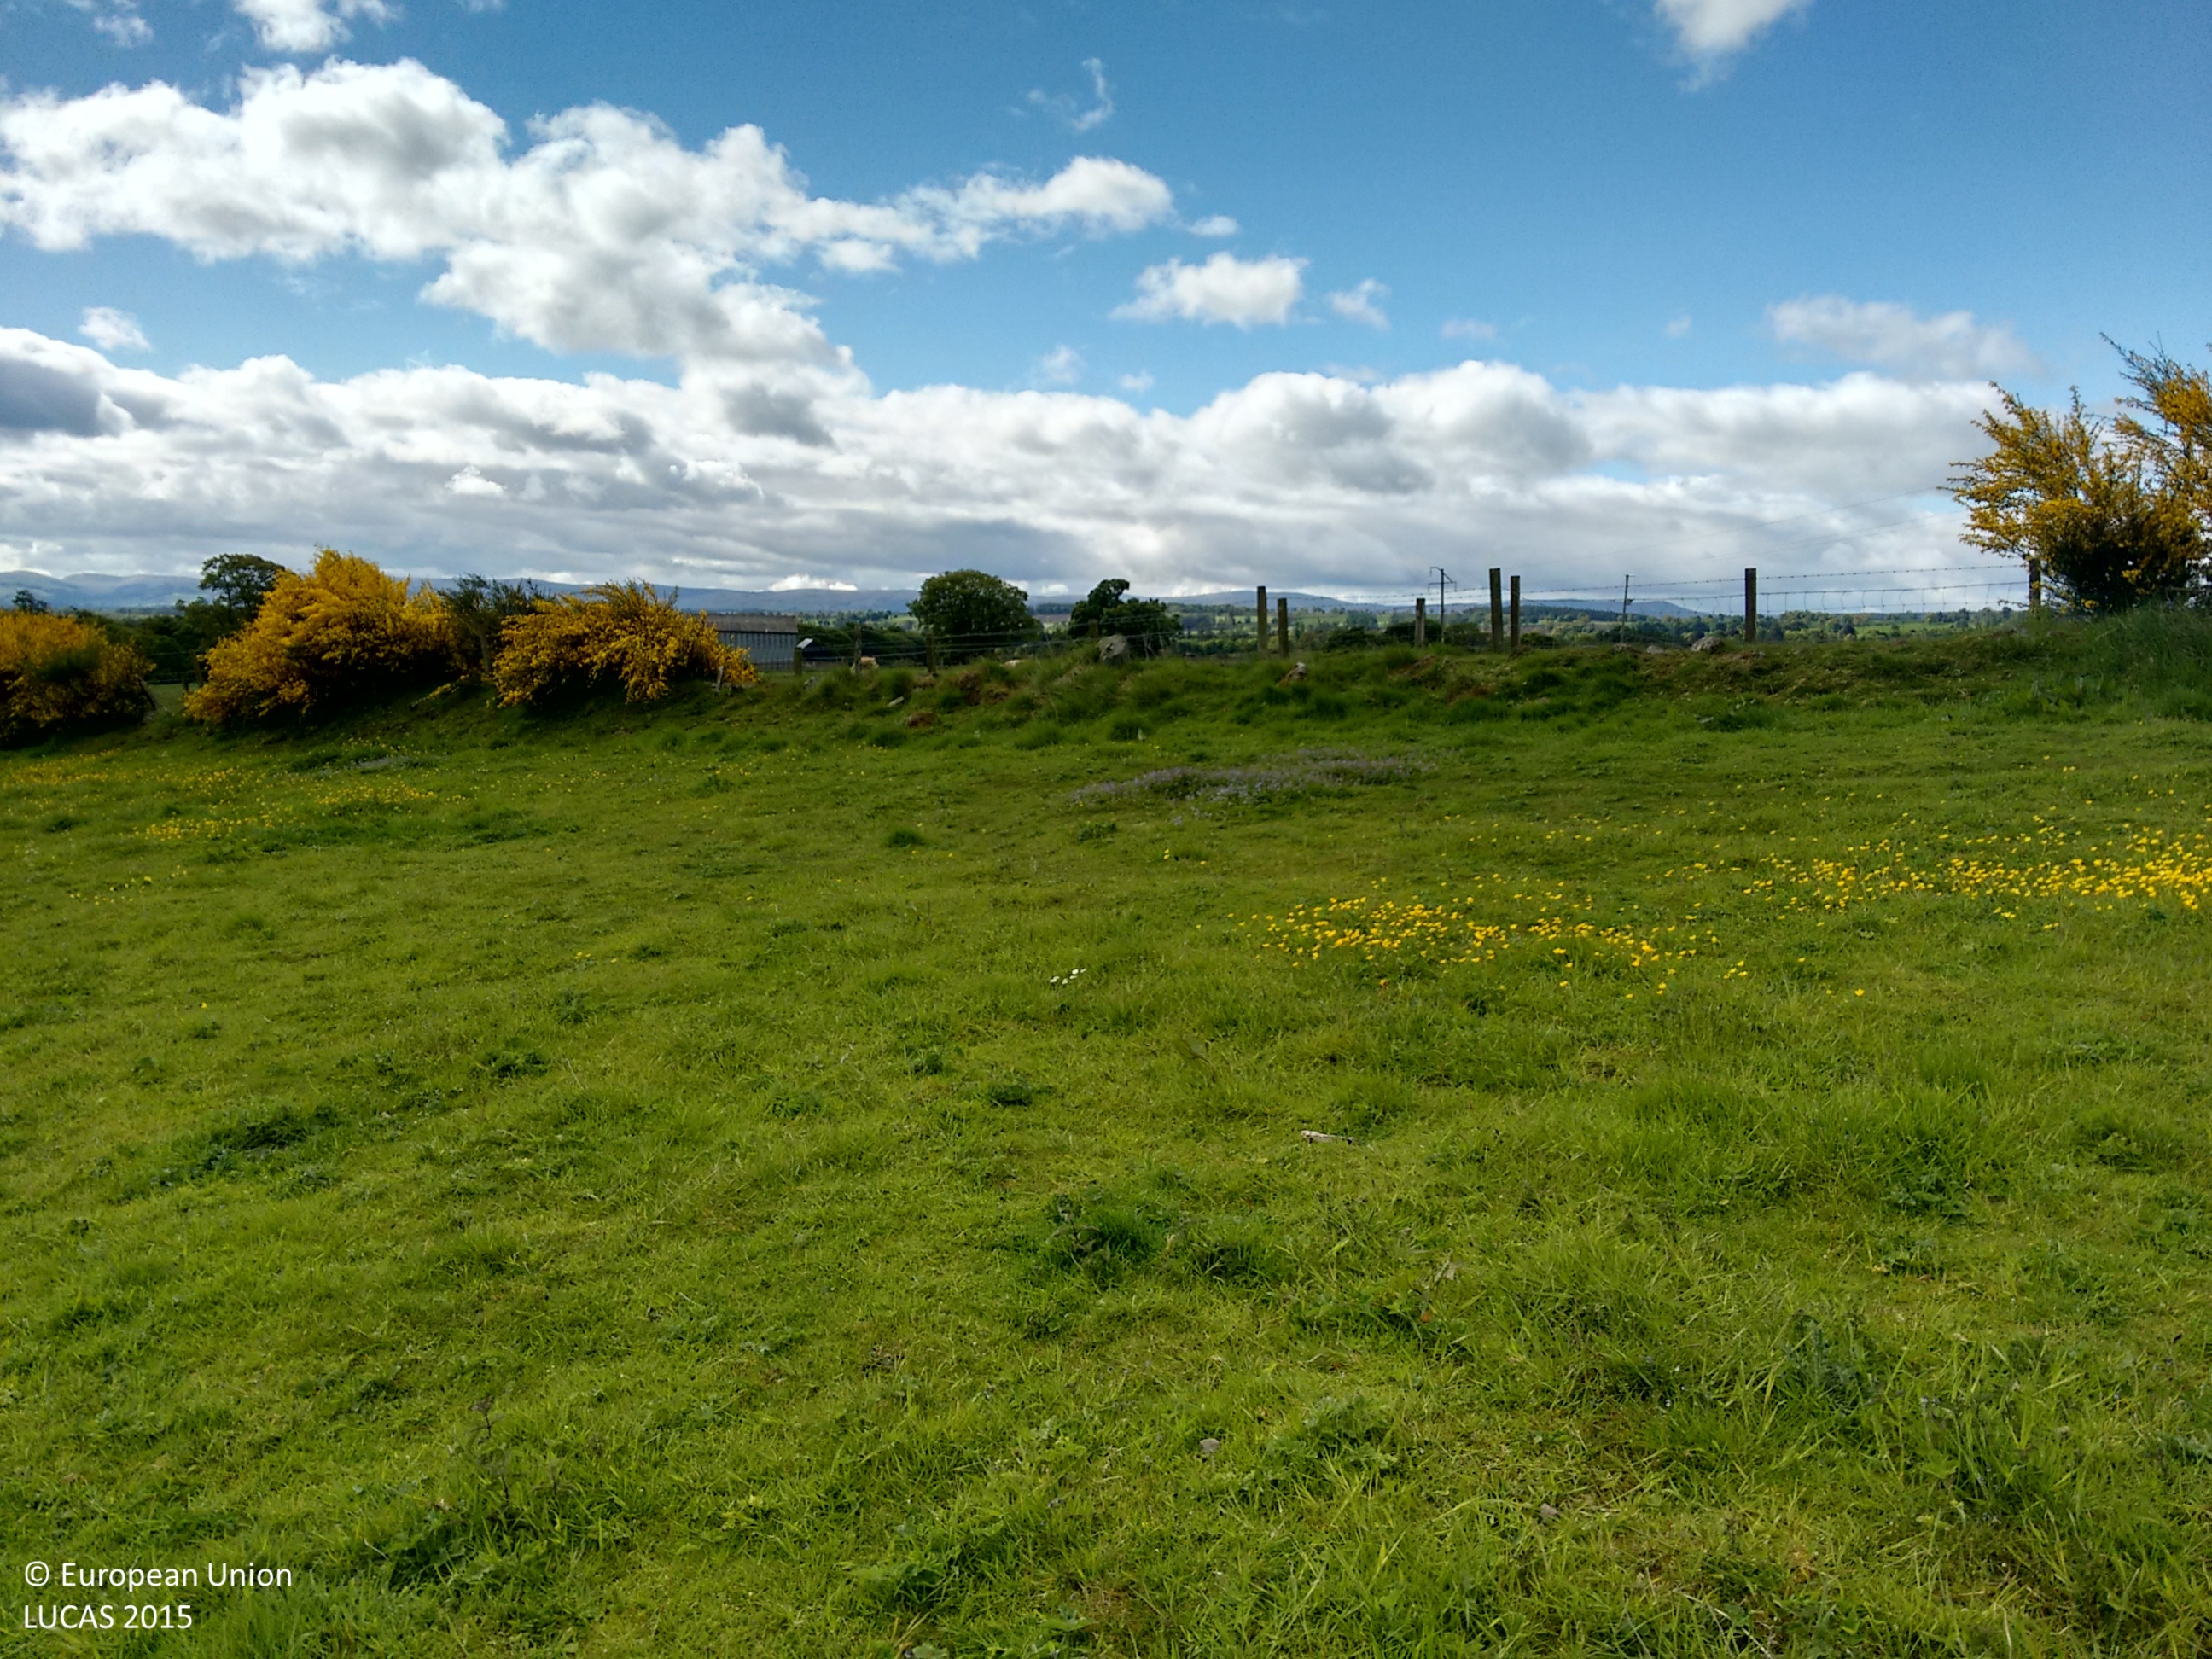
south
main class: Grassland
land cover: Grassland without tree/shrub cover
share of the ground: > 75 %
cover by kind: herbaceous plants 100 %
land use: Agriculture (excluding fallow land and kitchen gardens)
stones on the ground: 10 - 25 %
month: June
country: GB
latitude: 56.3629
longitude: -3.8579
